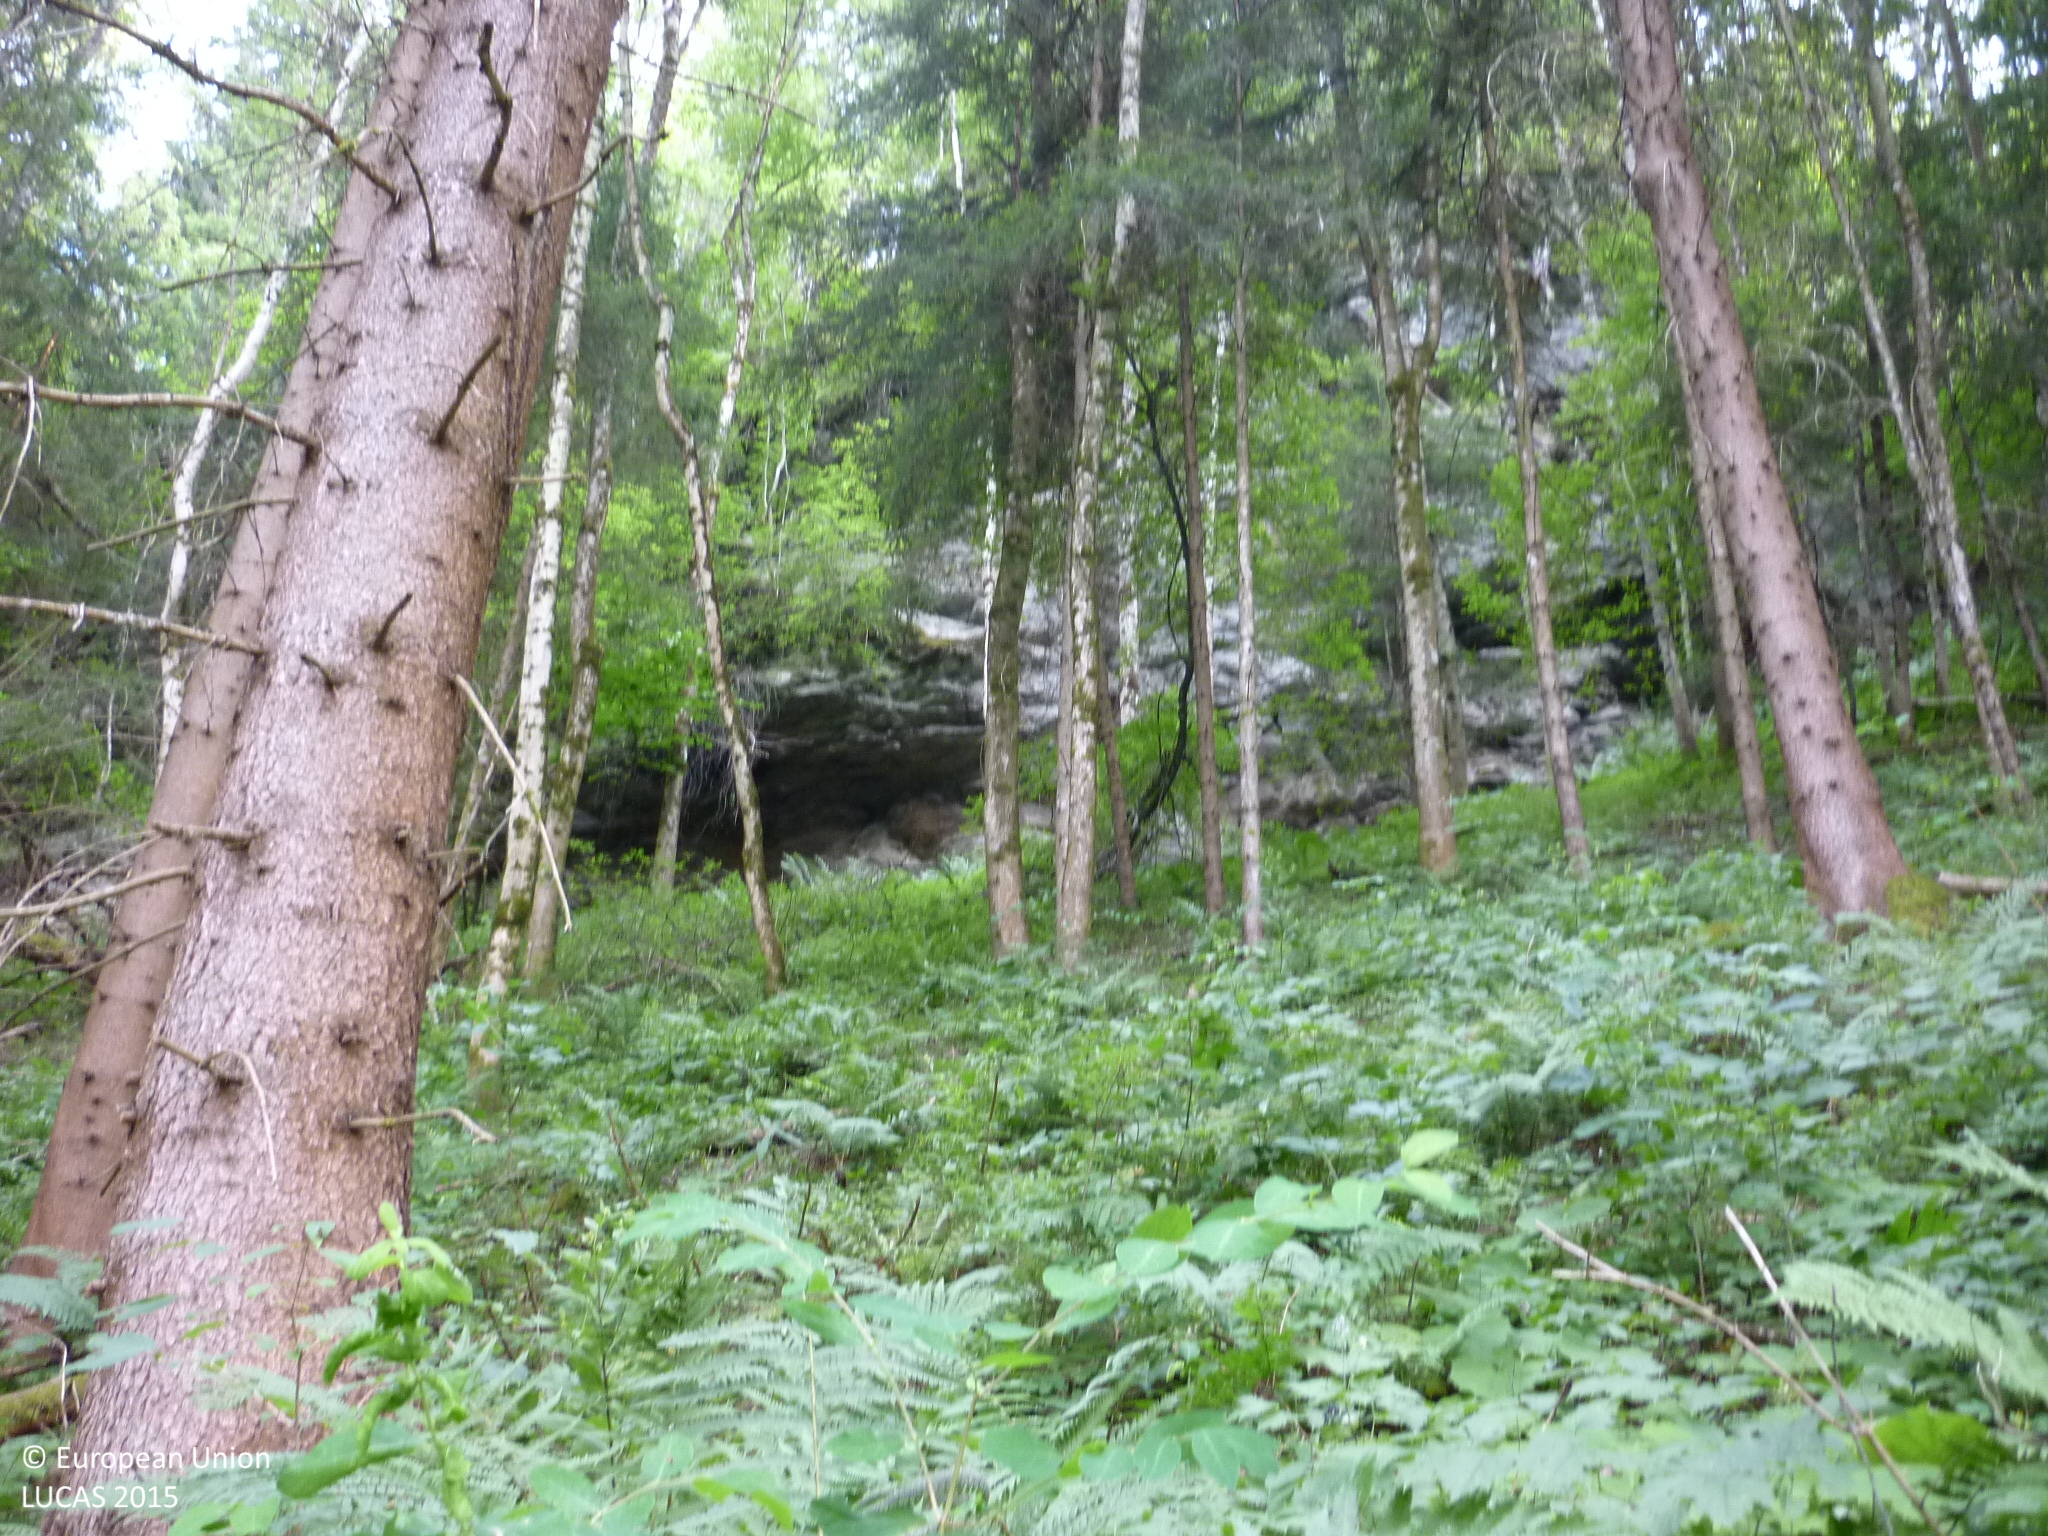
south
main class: Woodland
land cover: Spruce dominated coniferous woodland
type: alpine coniferous forest
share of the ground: > 75 %
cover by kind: coniferous forest trees 95 %, herbaceous plants 5 %
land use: Forestry
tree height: > 5 m
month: July
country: AT
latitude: 47.1300
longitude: 14.3092
